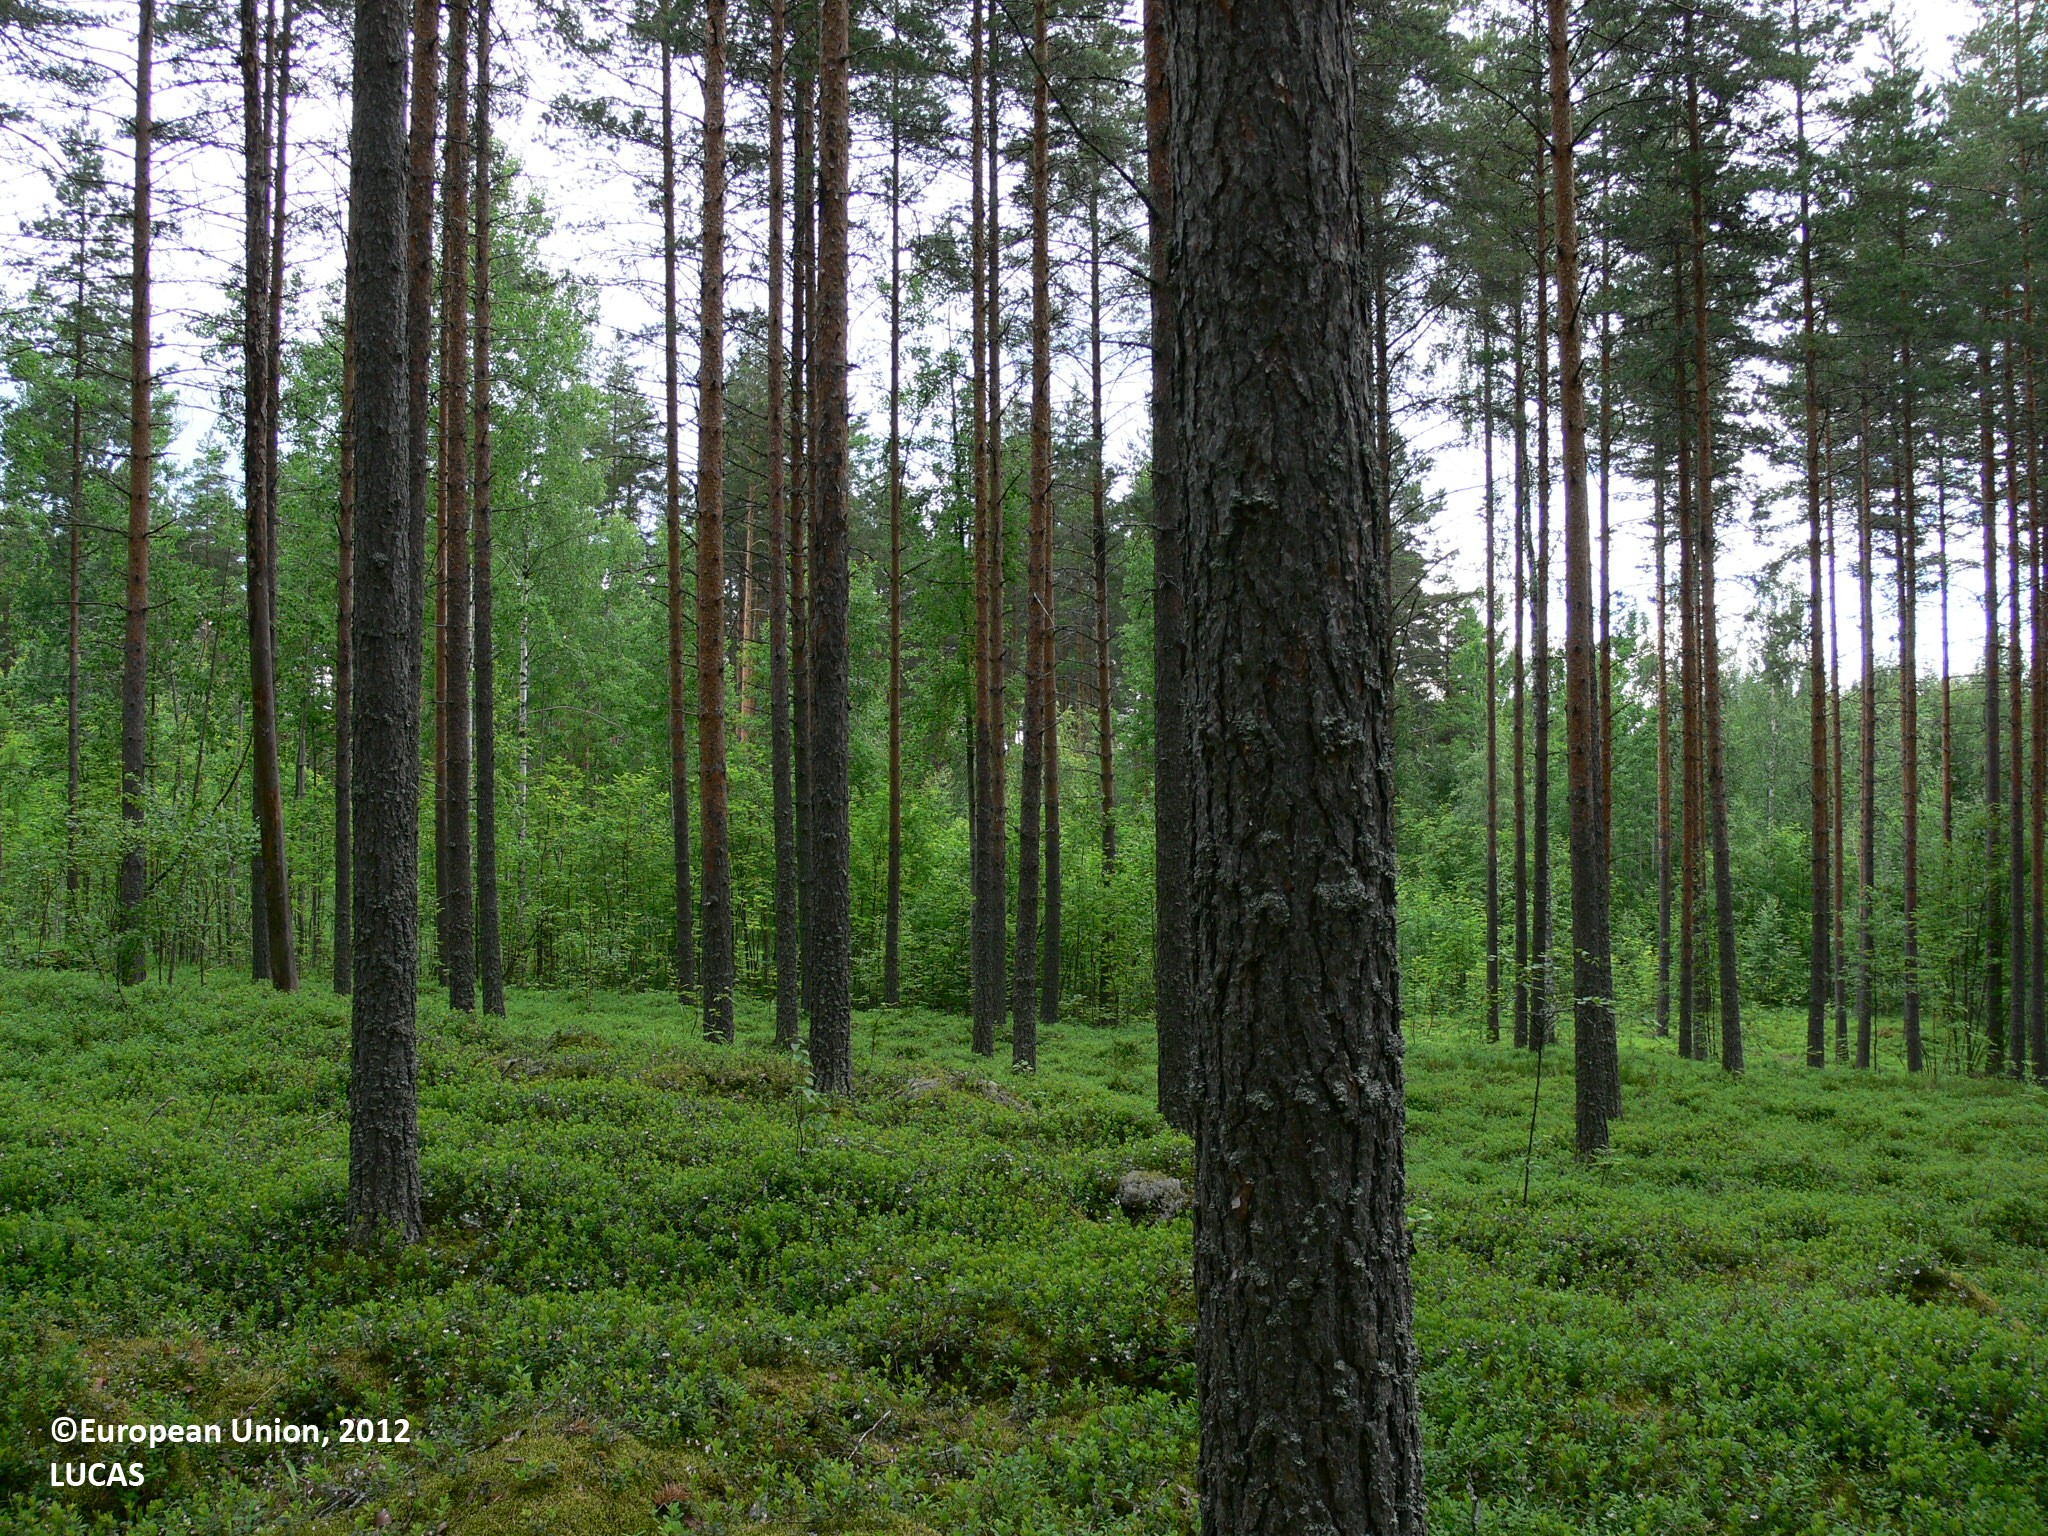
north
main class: Woodland
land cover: Pine dominated coniferous woodland
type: boreal forest
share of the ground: > 75 %
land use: Forestry
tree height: > 5 m
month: June
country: FI
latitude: 62.3984
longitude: 29.6518
